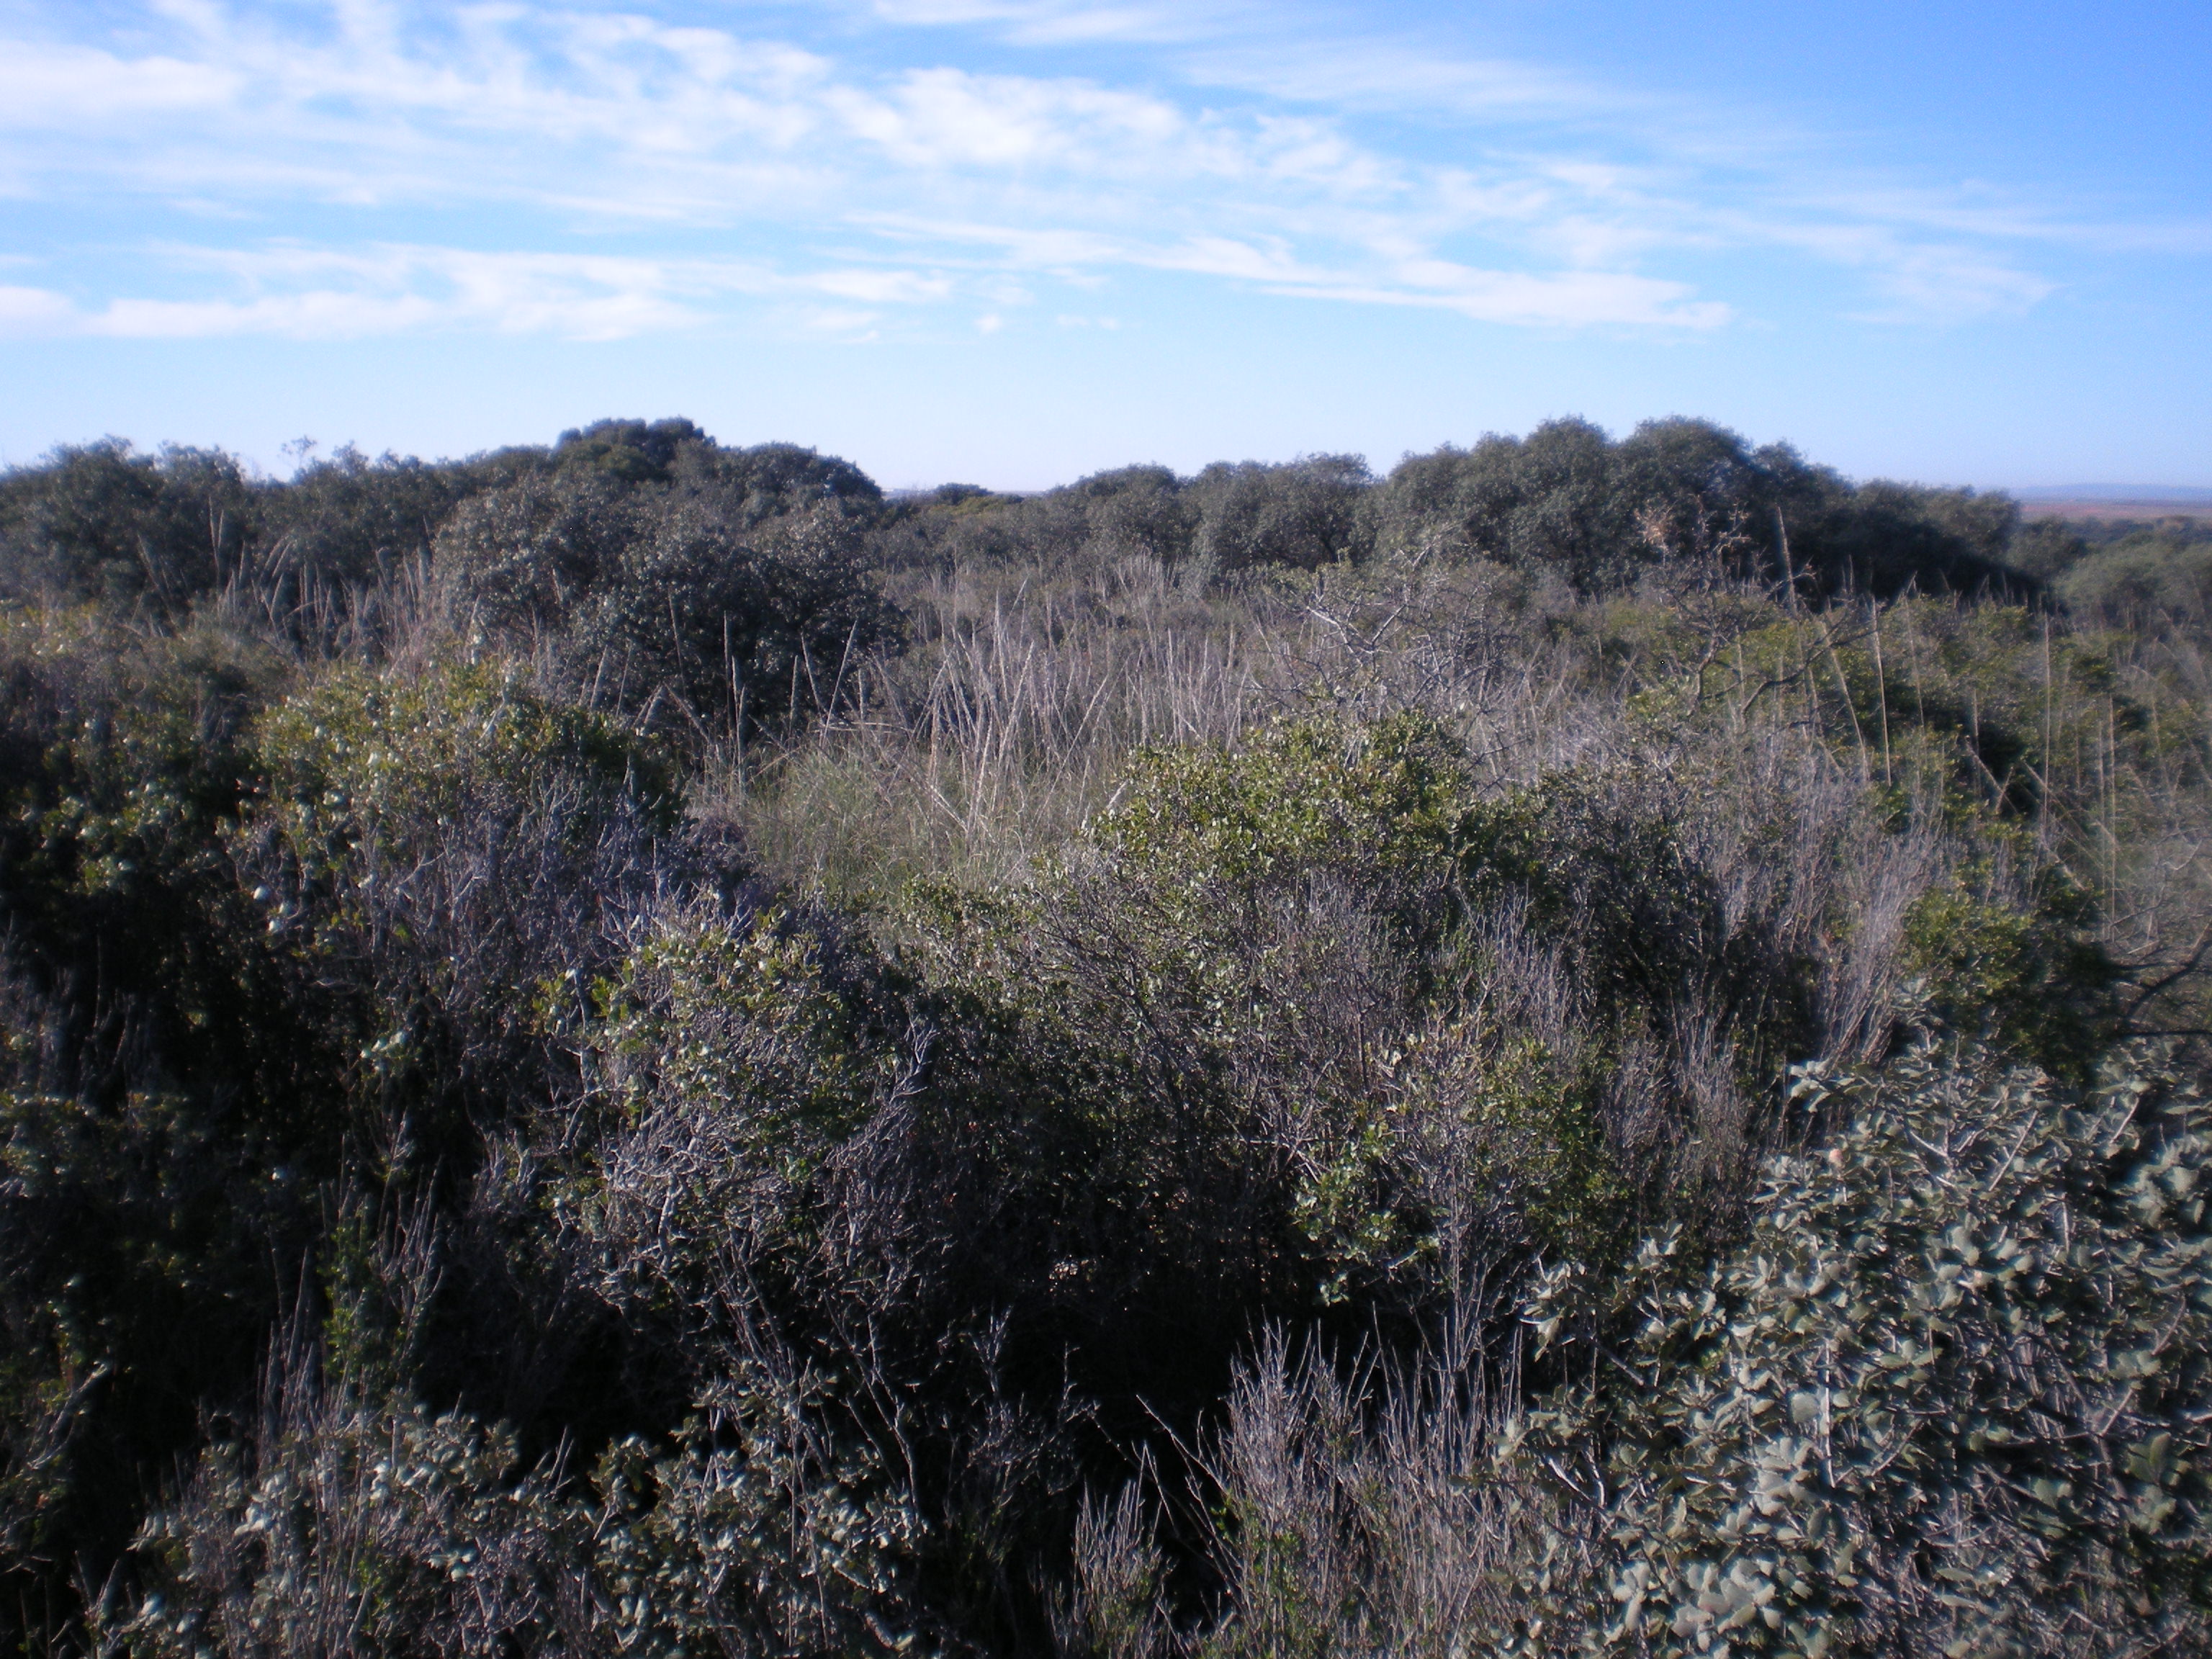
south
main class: Woodland
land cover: Broadleaved woodland
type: broadleaved evergreen forest
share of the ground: 25 - 50 %
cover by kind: shrubs 50 %, broadleaved forest trees 25 %, consolidated bare surface 20 %, herbaceous plants 5 %
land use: Semi-natural and natural areas not in use
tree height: < 5 m
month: April
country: ES
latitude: 38.8290
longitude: -3.0131
